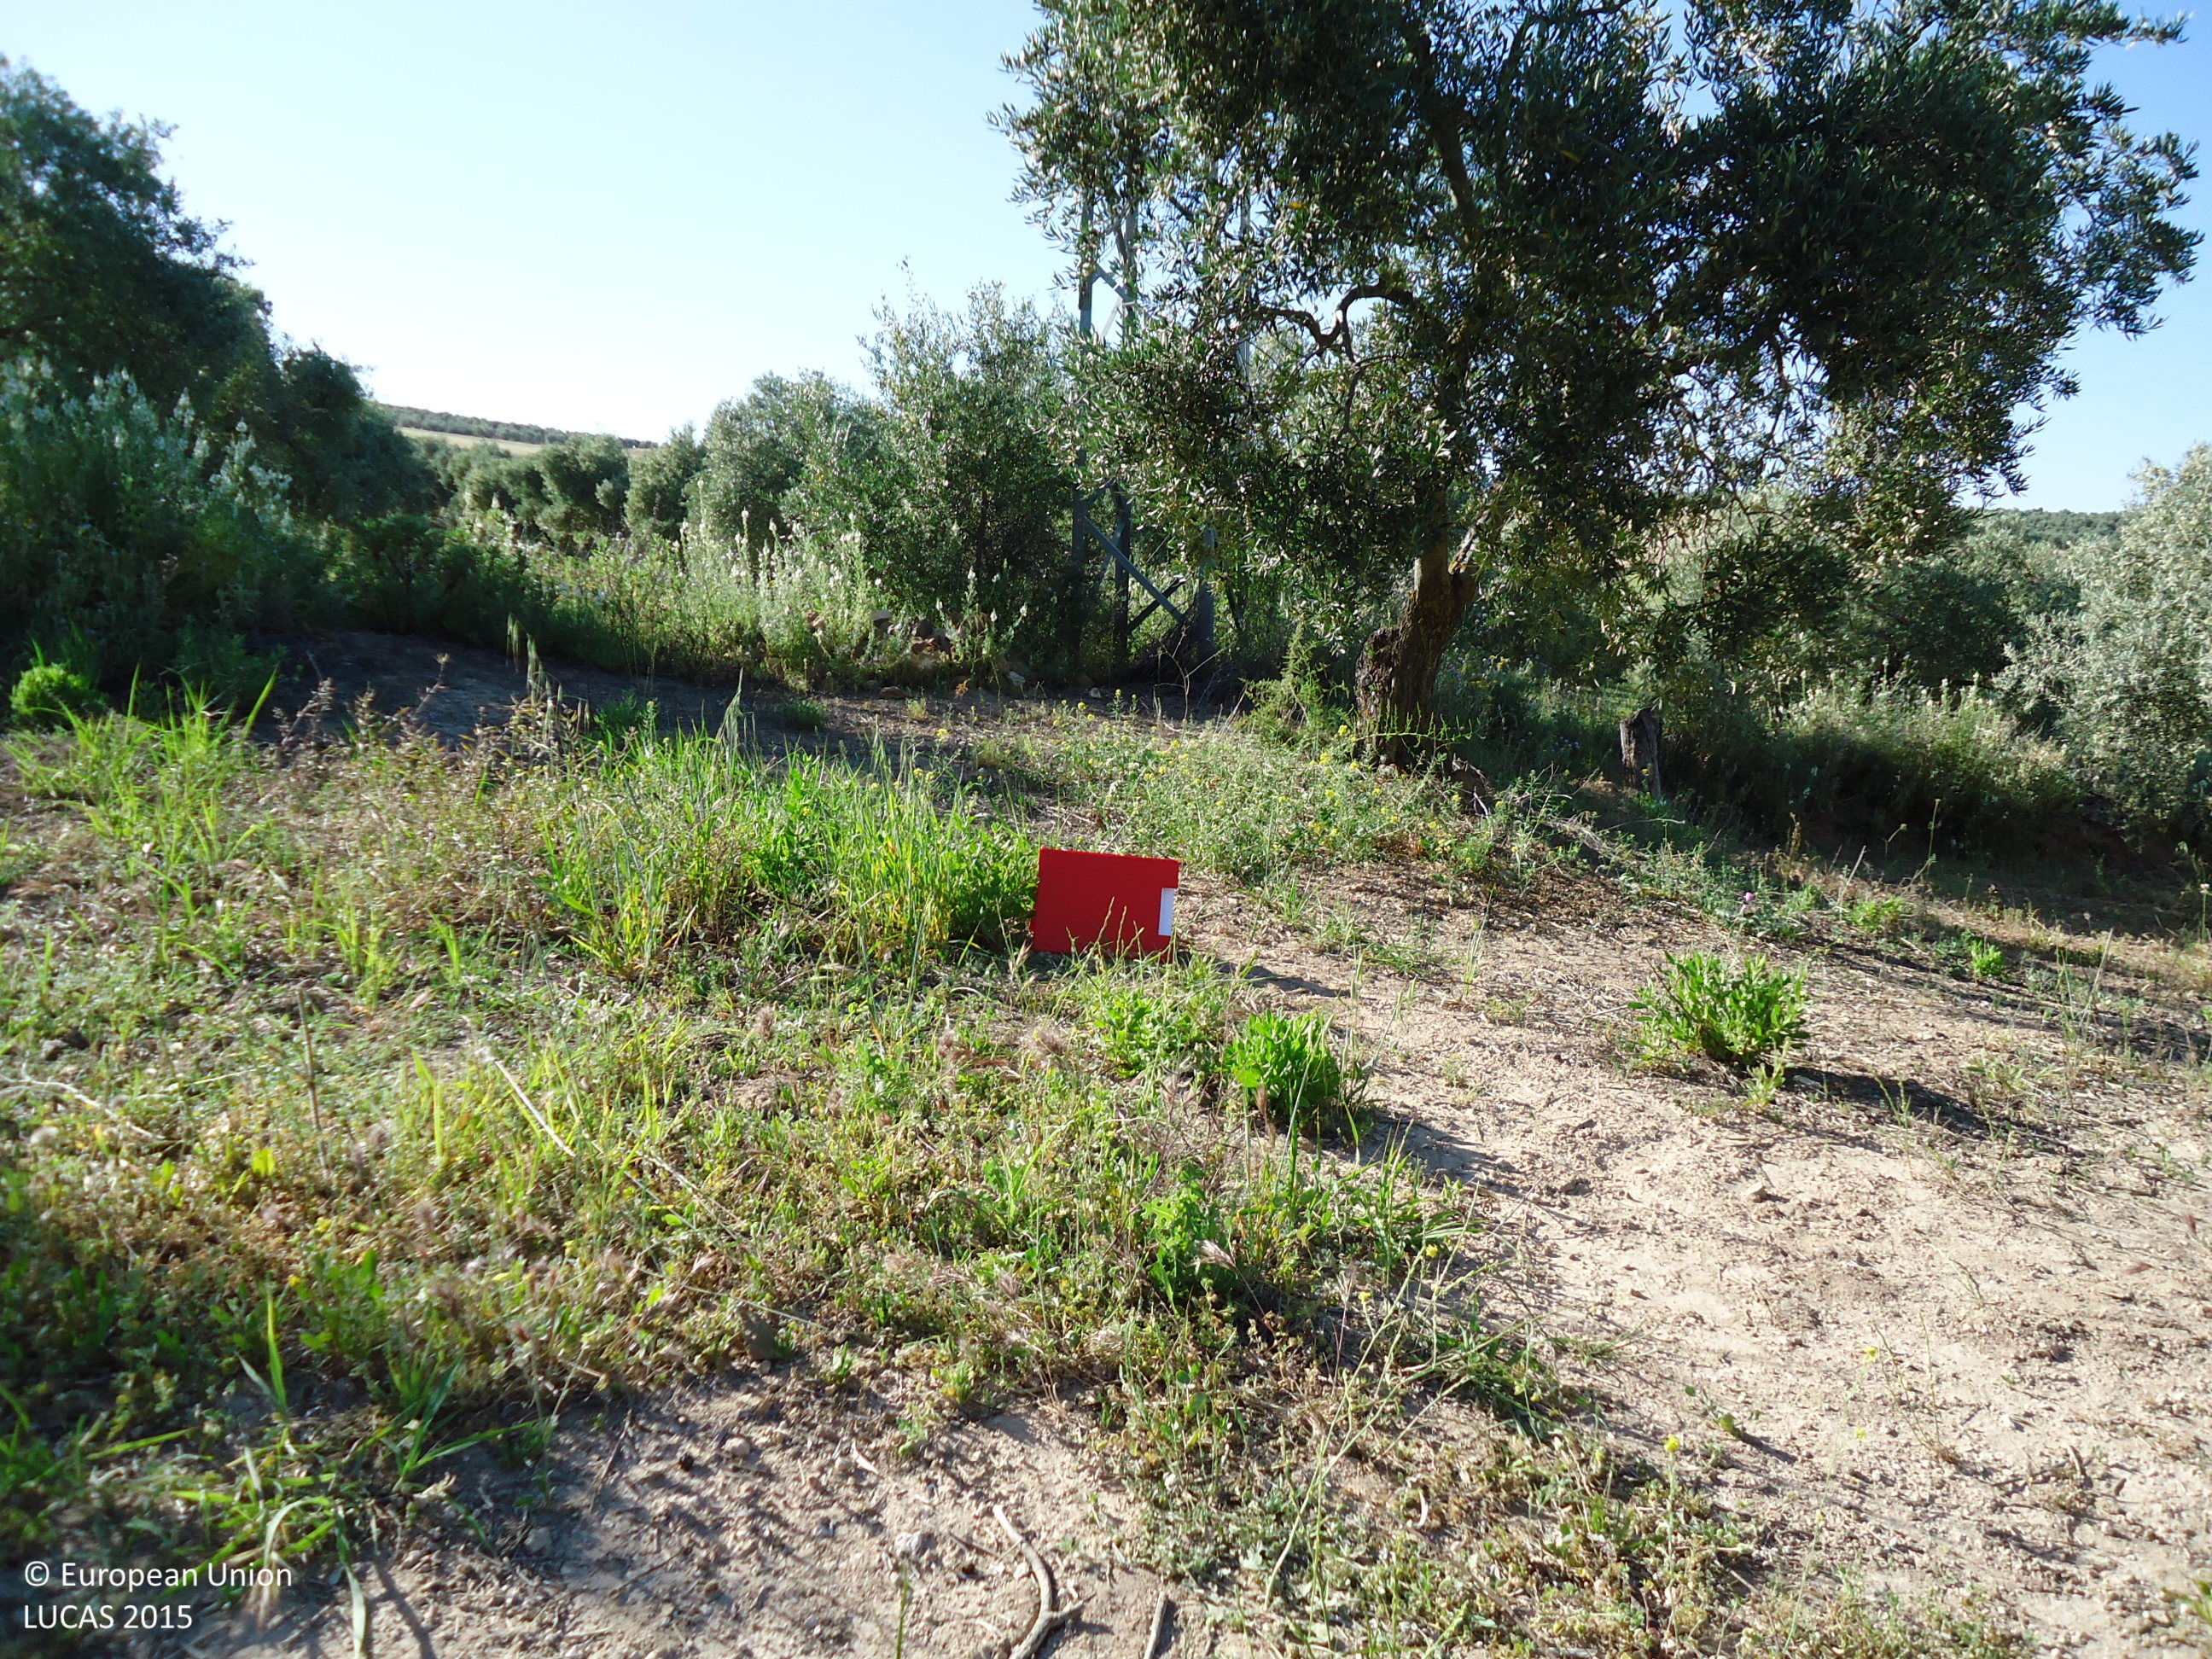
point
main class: Cropland
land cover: Olive groves
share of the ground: > 75 %
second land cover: Spontaneously vegetated surfaces
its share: 50 - 75 %
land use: Agriculture (excluding fallow land and kitchen gardens)
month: May
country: ES
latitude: 36.8817
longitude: -5.0004
